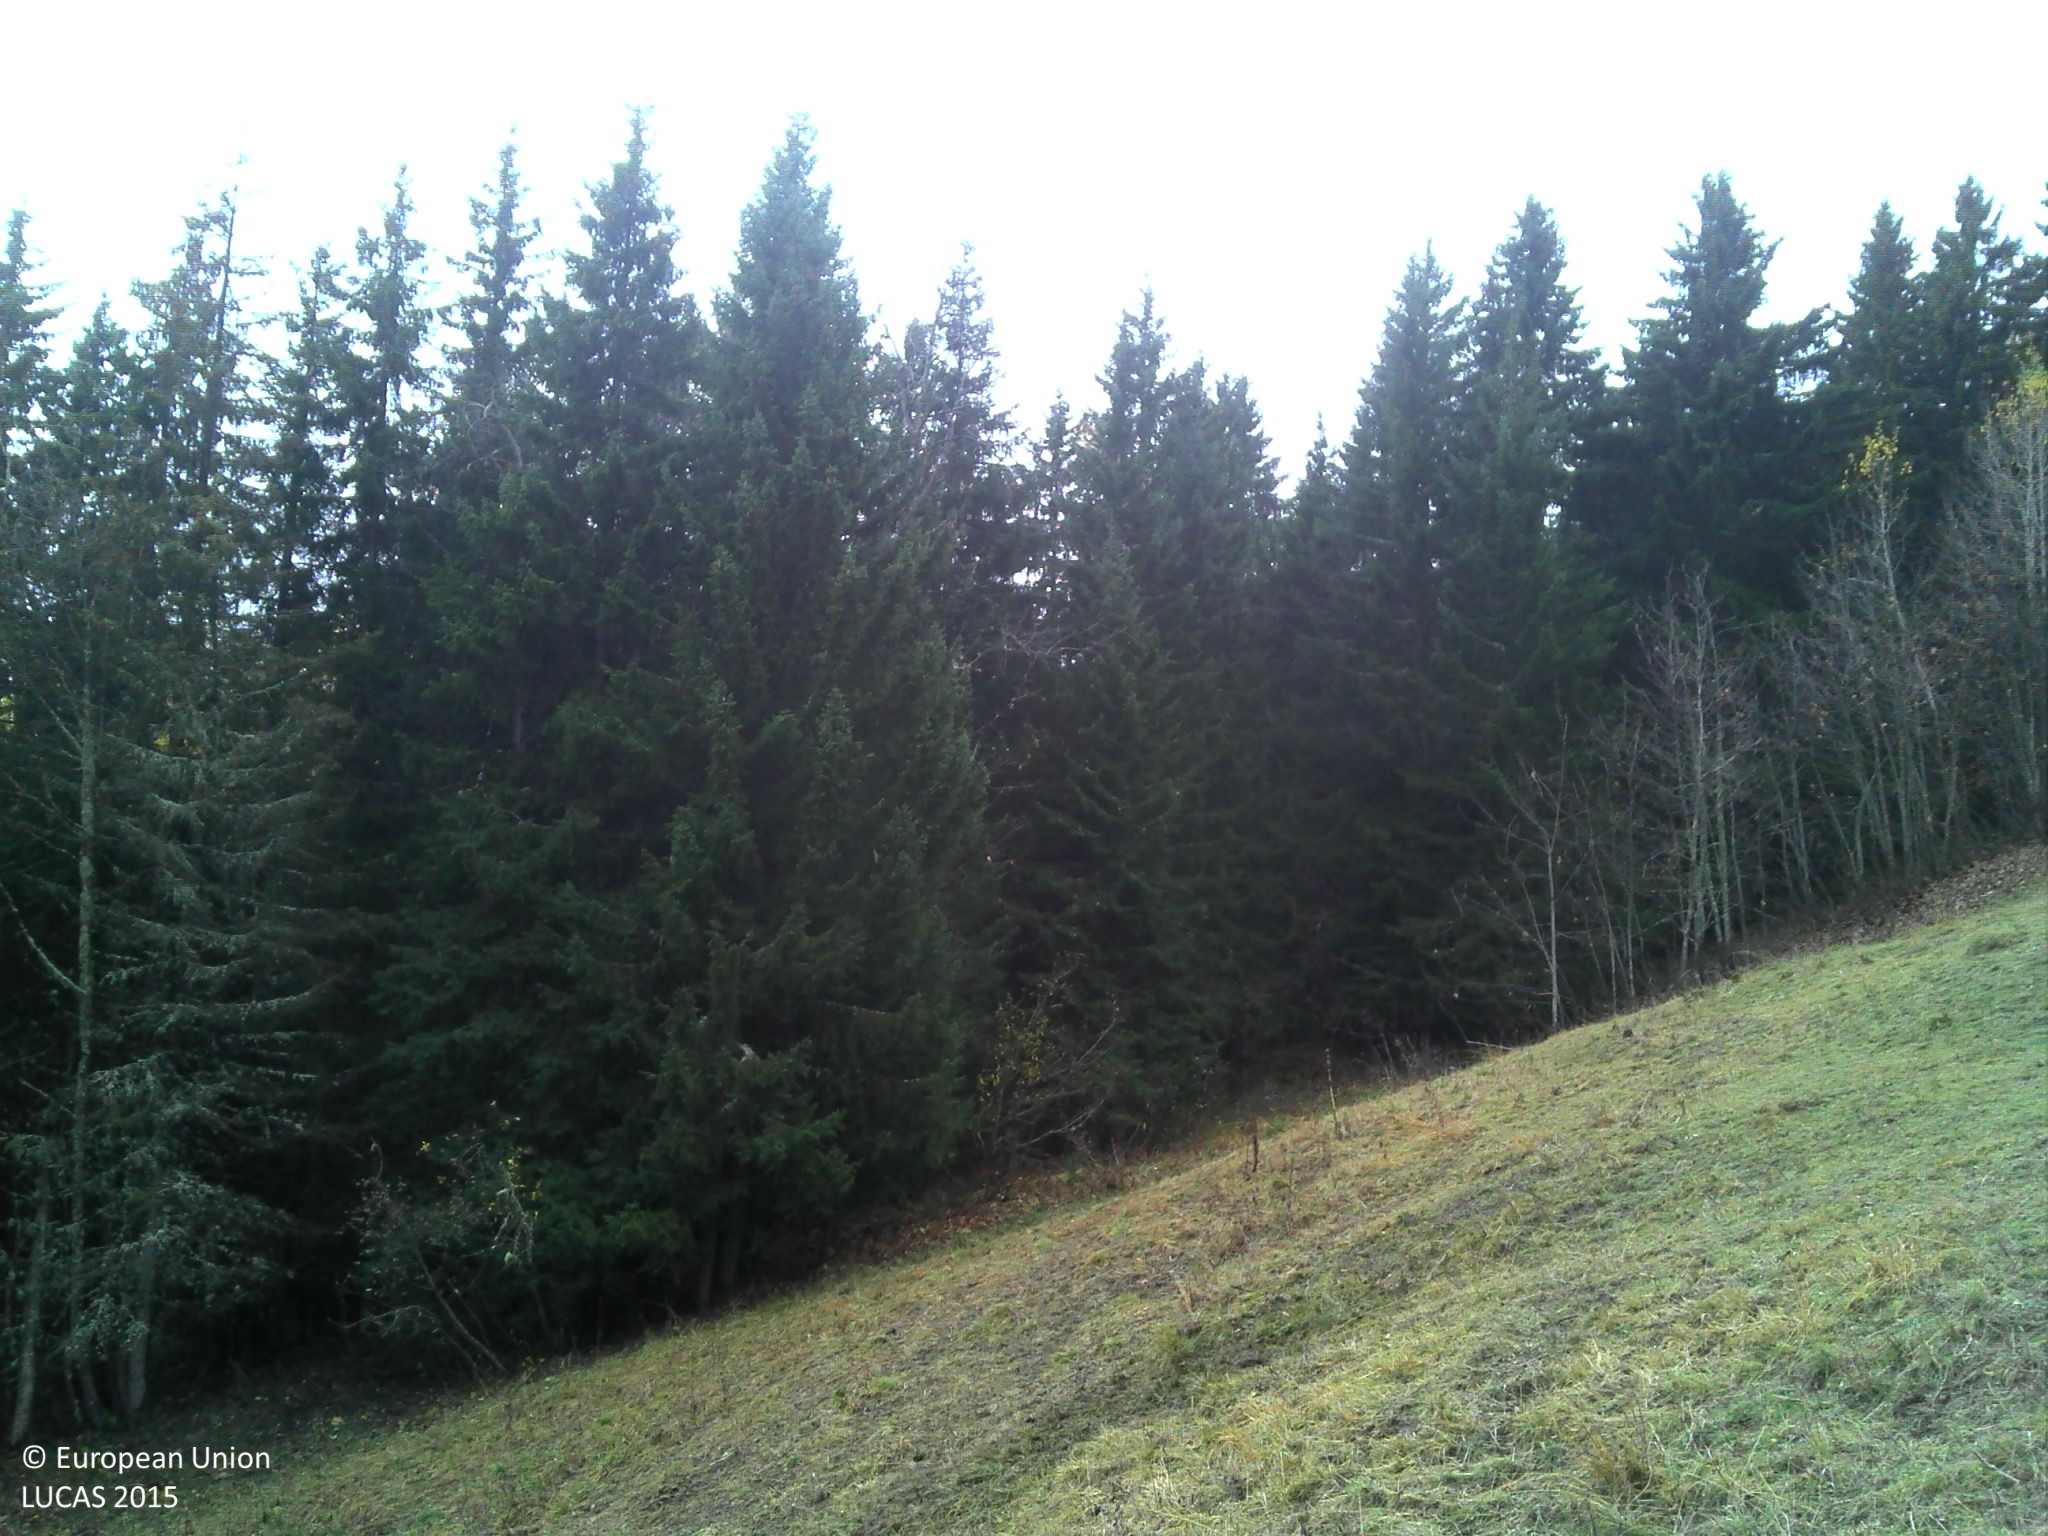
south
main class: Grassland
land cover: Grassland without tree/shrub cover
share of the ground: > 75 %
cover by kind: herbaceous plants 95 %, shrubs 5 %
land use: Agriculture (excluding fallow land and kitchen gardens)
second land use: Sport
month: October
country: FR
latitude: 45.4623
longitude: 6.4365
